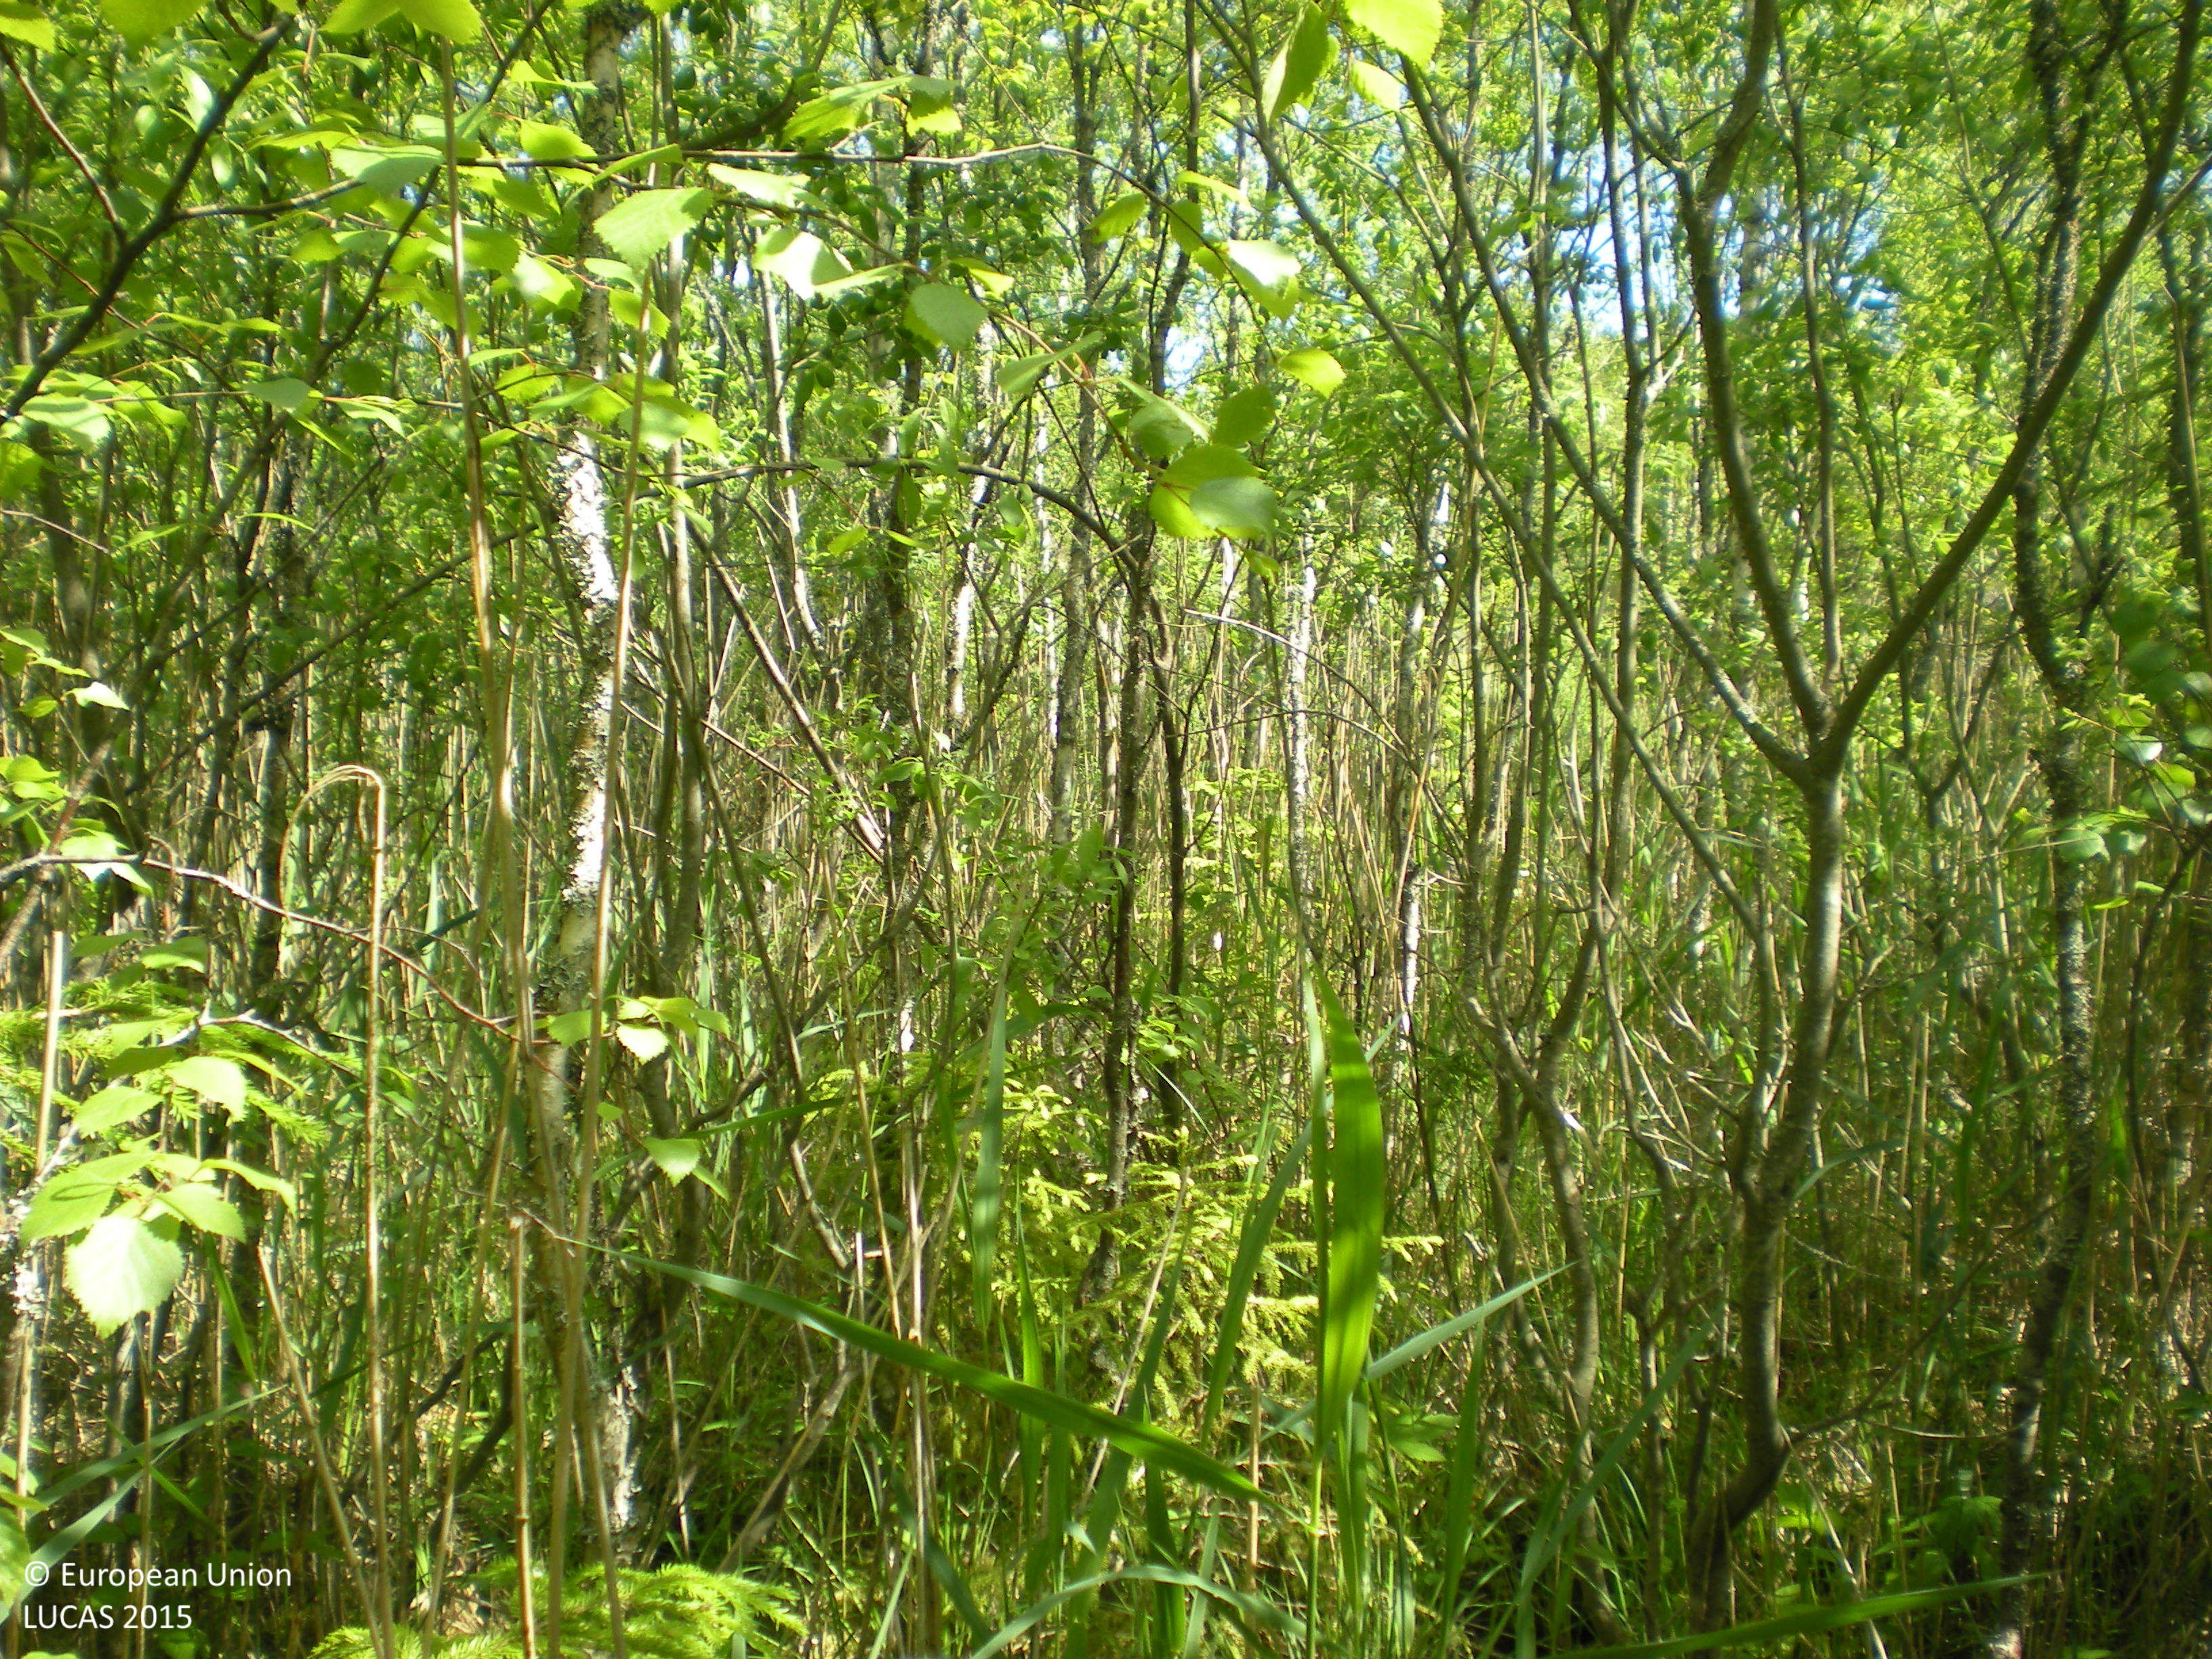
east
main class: Woodland
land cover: Broadleaved woodland
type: mire and swamp forests
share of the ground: > 75 %
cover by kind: broadleaved forest trees 80 %, herbaceous plants 10 %, coniferous forest trees 5 %, shrubs 5 %
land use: Semi-natural and natural areas not in use
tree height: < 5 m
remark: Temporary flooded
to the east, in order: Broadleaved woodland; Pine dominated coniferous woodland; Inland marshes
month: June
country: SE
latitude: 60.4776
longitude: 18.0160
